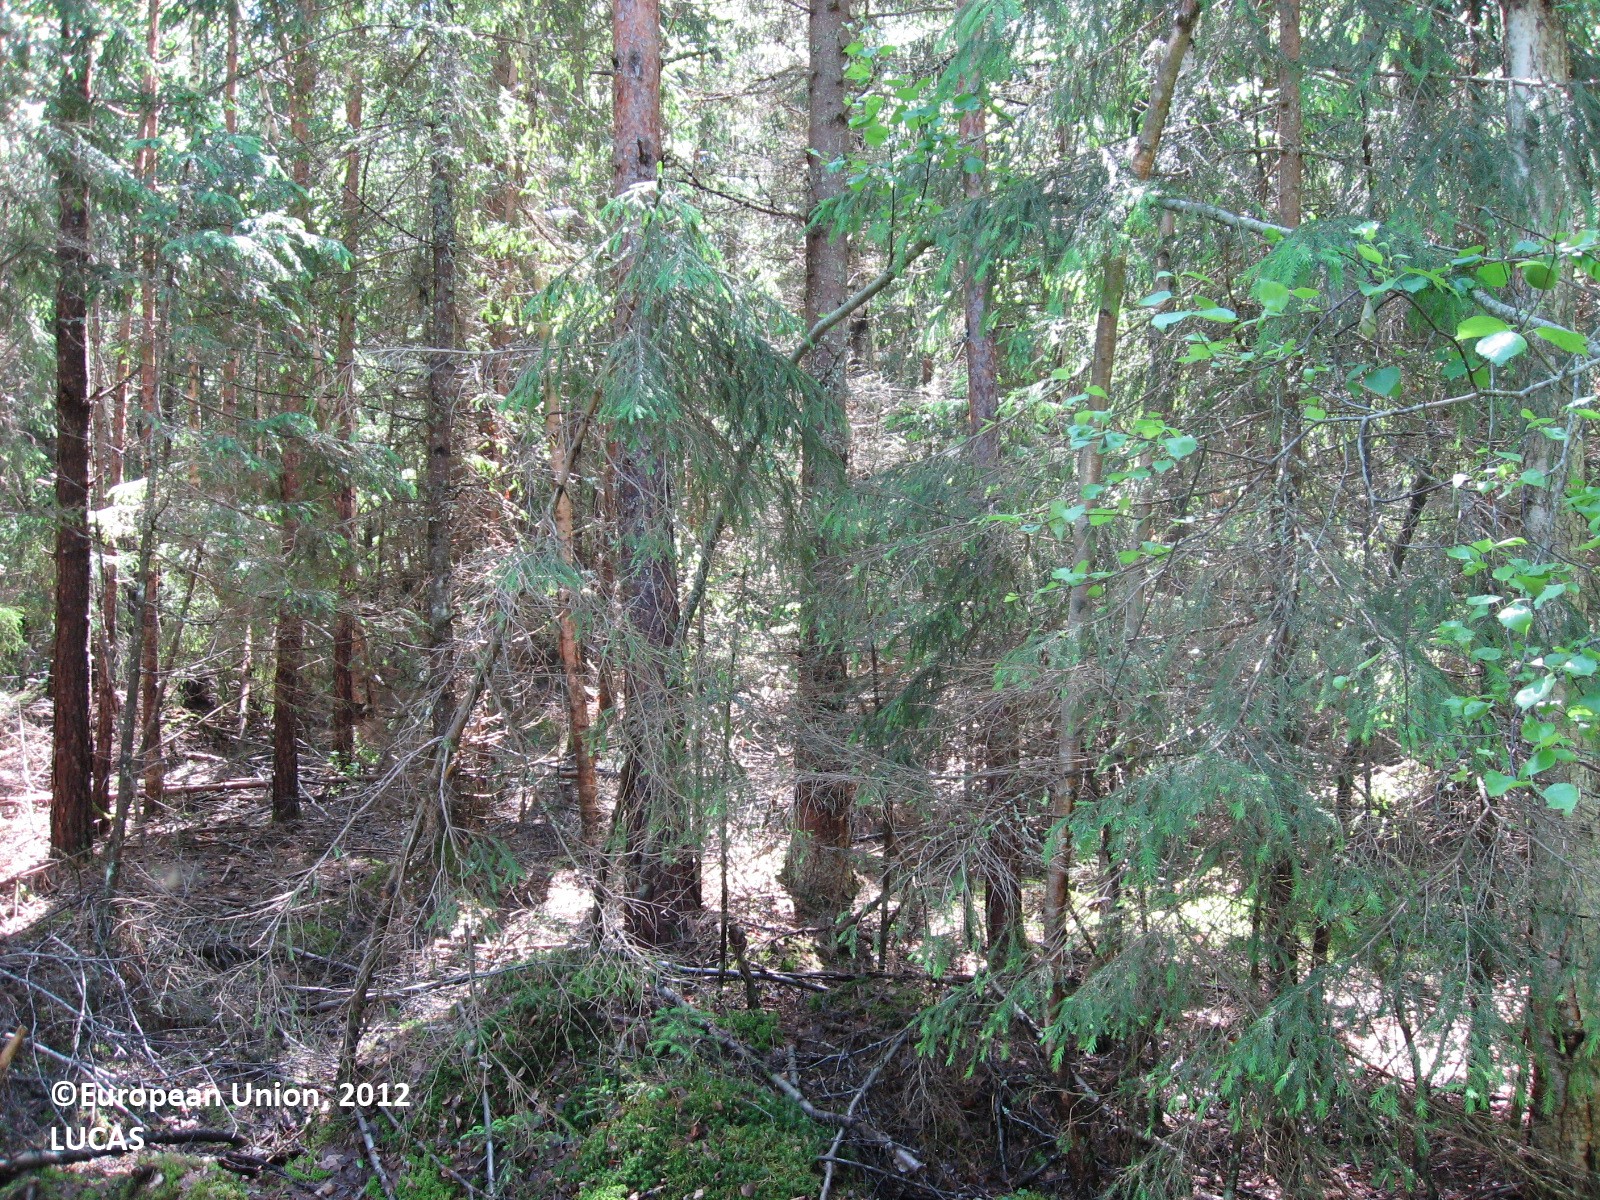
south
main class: Woodland
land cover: Other coniferous woodland
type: boreal forest
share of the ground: 50 - 75 %
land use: Forestry
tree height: > 5 m
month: June
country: FI
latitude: 60.5266
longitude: 26.3495
